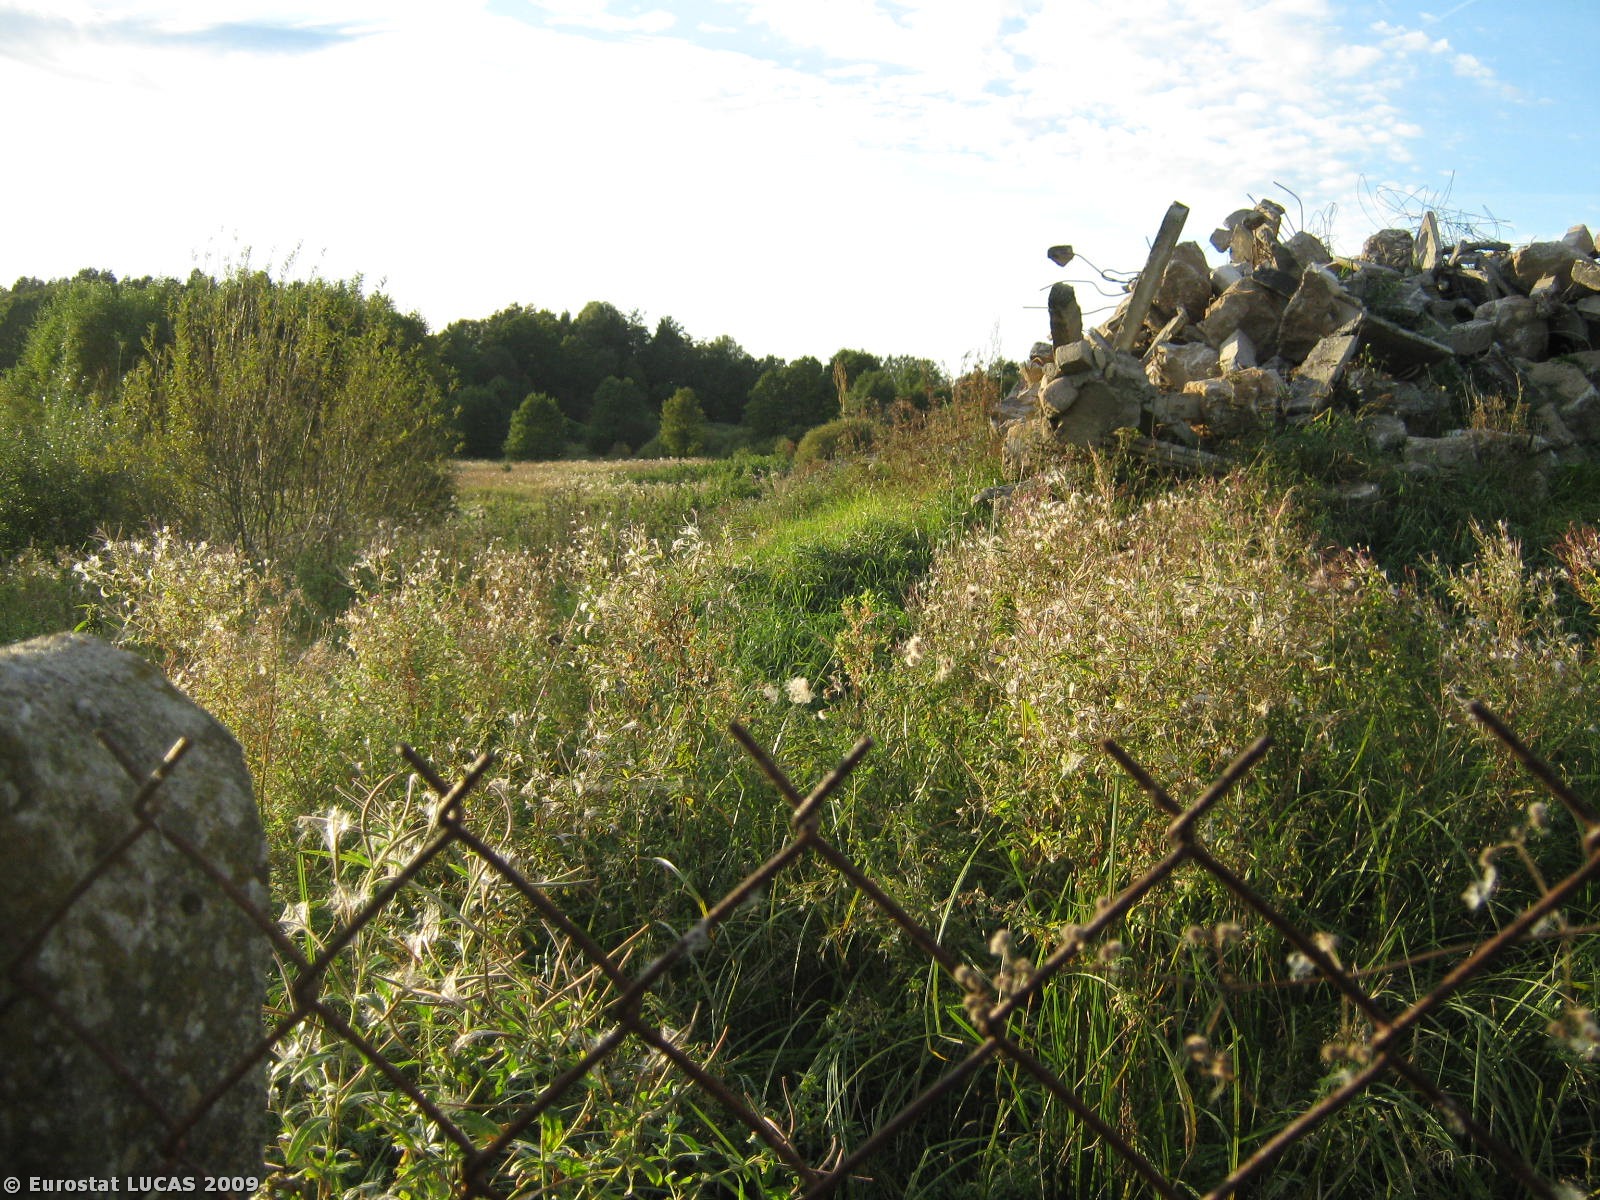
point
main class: Grassland
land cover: Grassland with sparse tree/shrub cover
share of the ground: > 75 %
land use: Community services
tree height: < 5 m
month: September
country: PL
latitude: 53.9627
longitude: 16.5760
